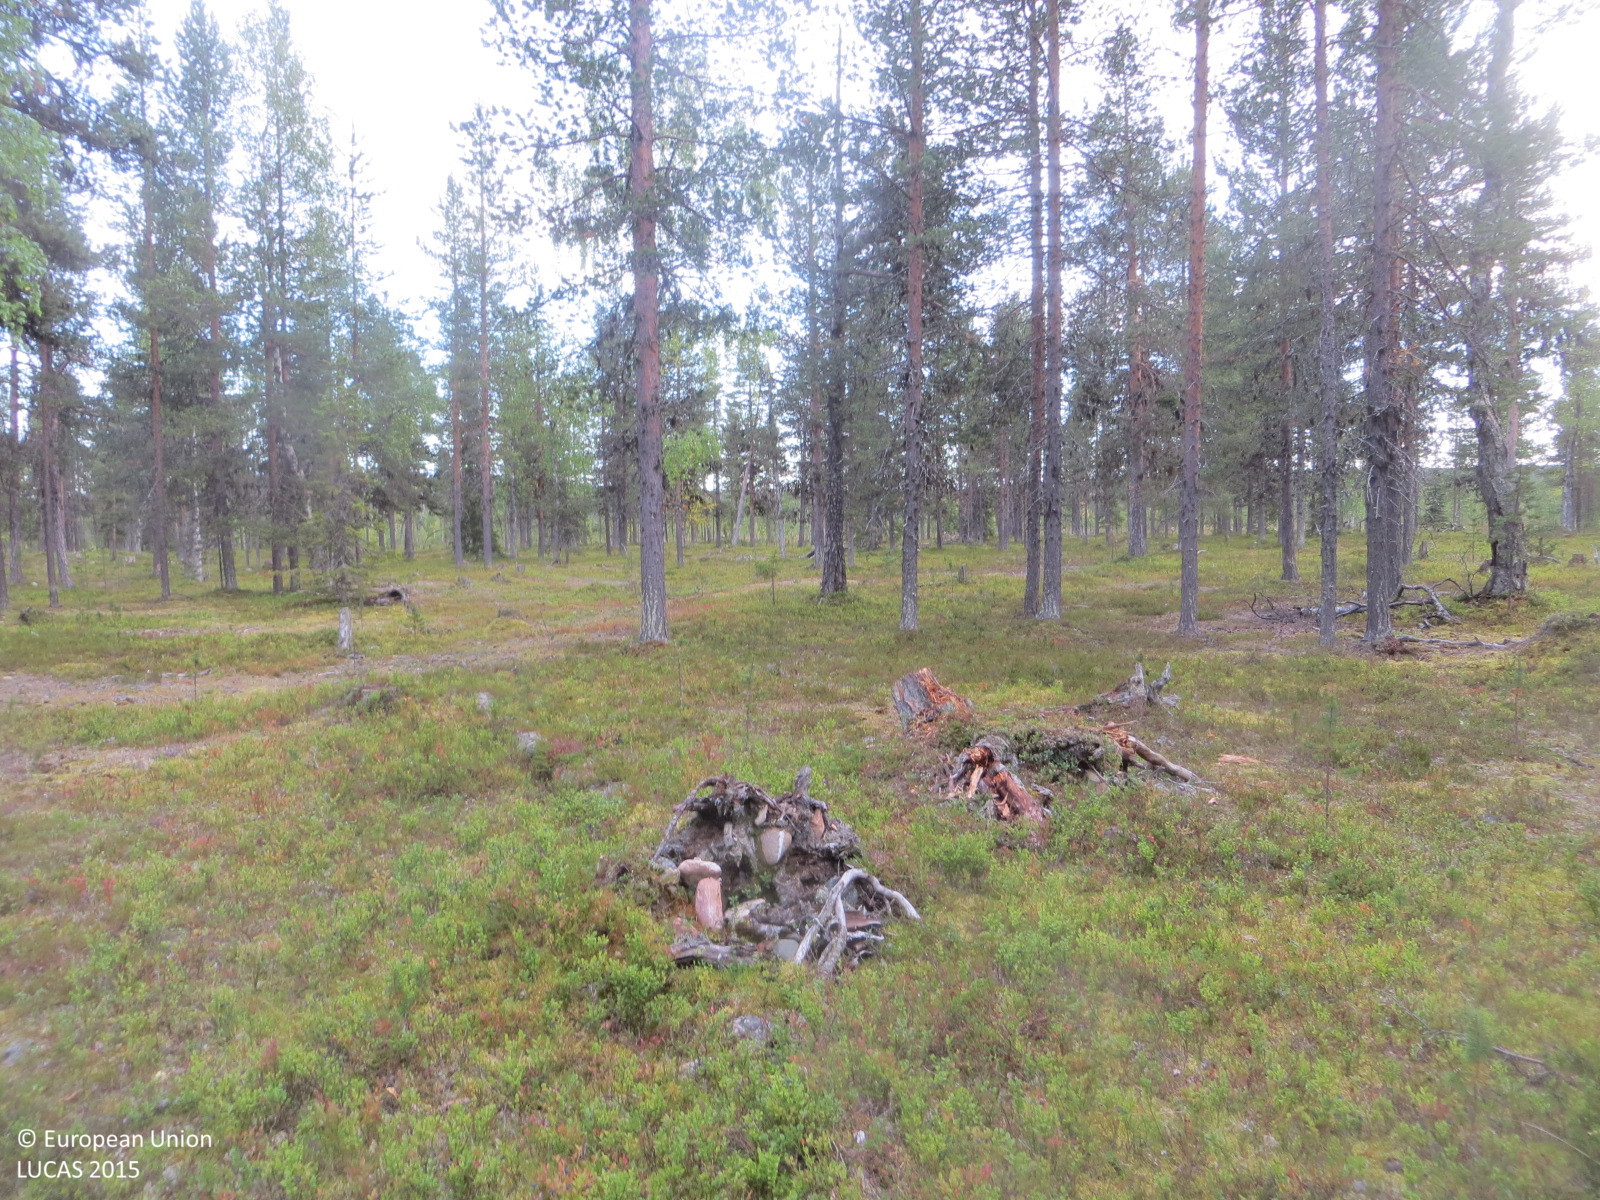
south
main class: Woodland
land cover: Pine dominated mixed woodland
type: boreal forest
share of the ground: 25 - 50 %
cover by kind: shrubs 60 %, coniferous forest trees 30 %, broadleaved forest trees 10 %
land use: Forestry
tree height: > 5 m
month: September
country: FI
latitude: 67.9250
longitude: 24.4490
